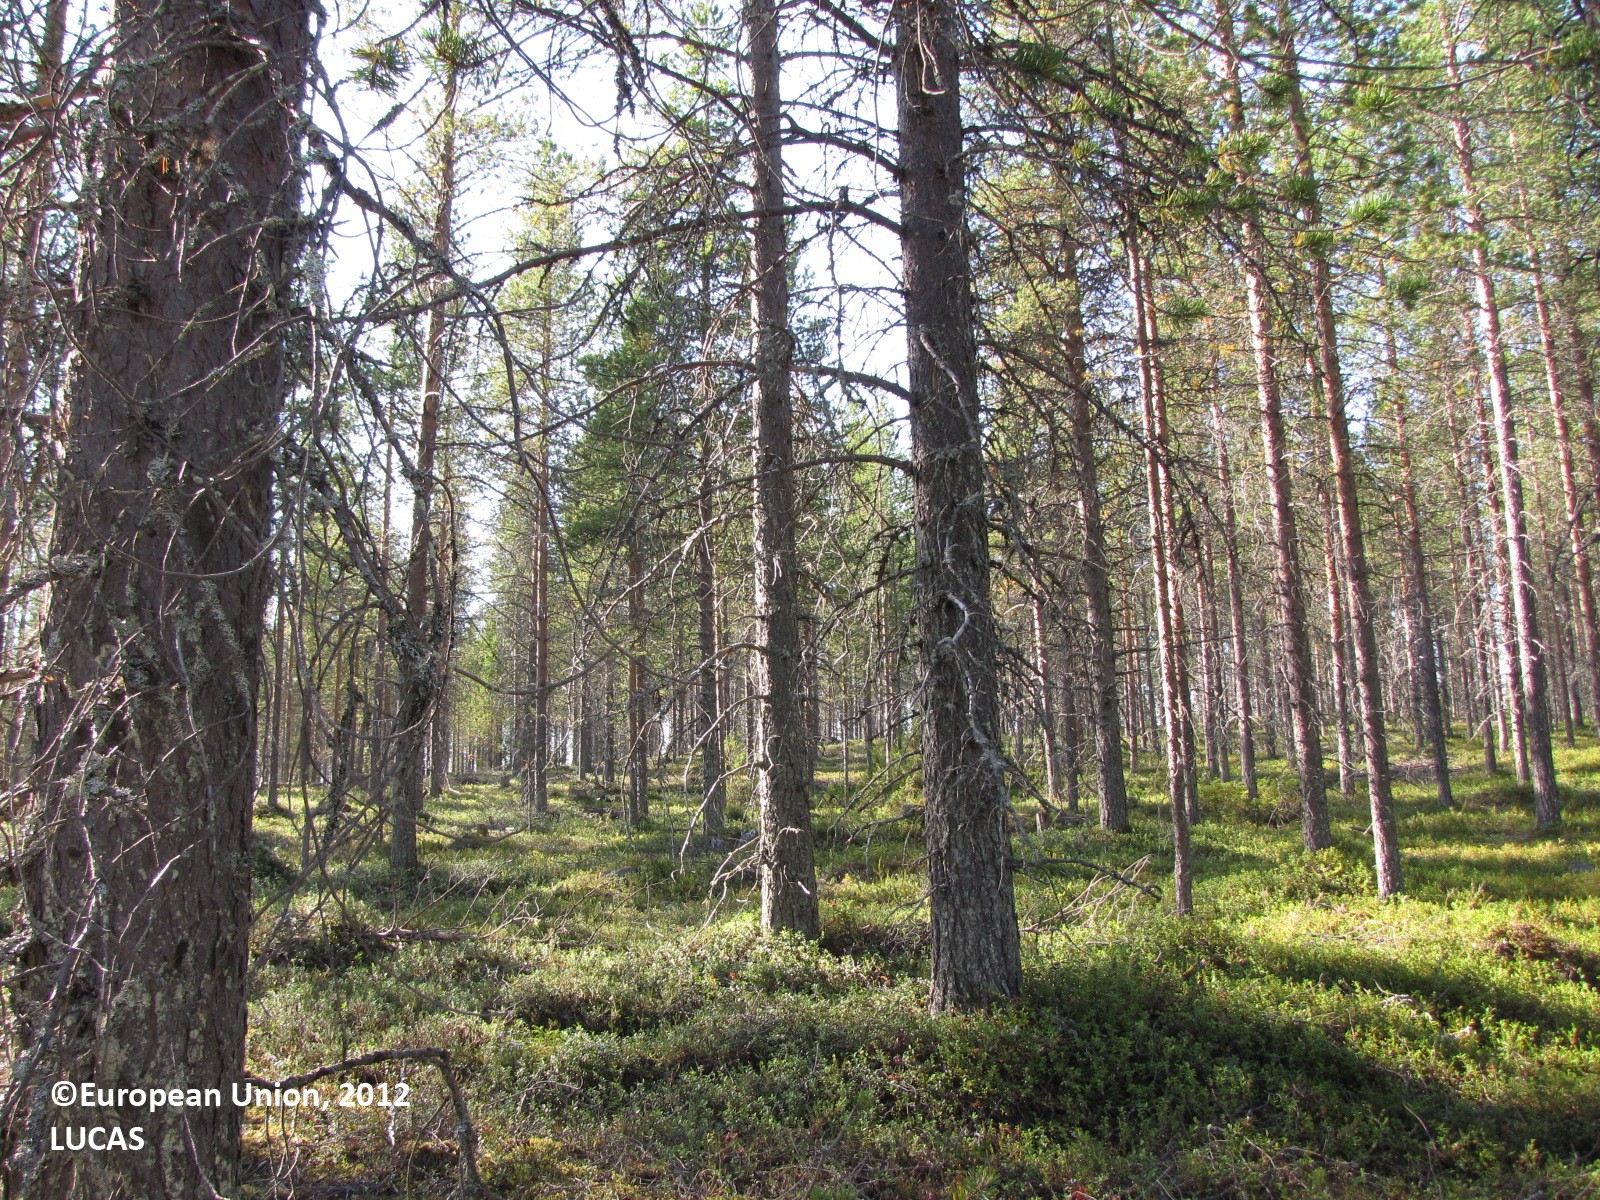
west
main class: Woodland
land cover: Pine dominated coniferous woodland
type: boreal forest
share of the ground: 25 - 50 %
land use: Forestry
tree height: > 5 m
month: August
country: FI
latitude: 67.0071
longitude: 25.2150
